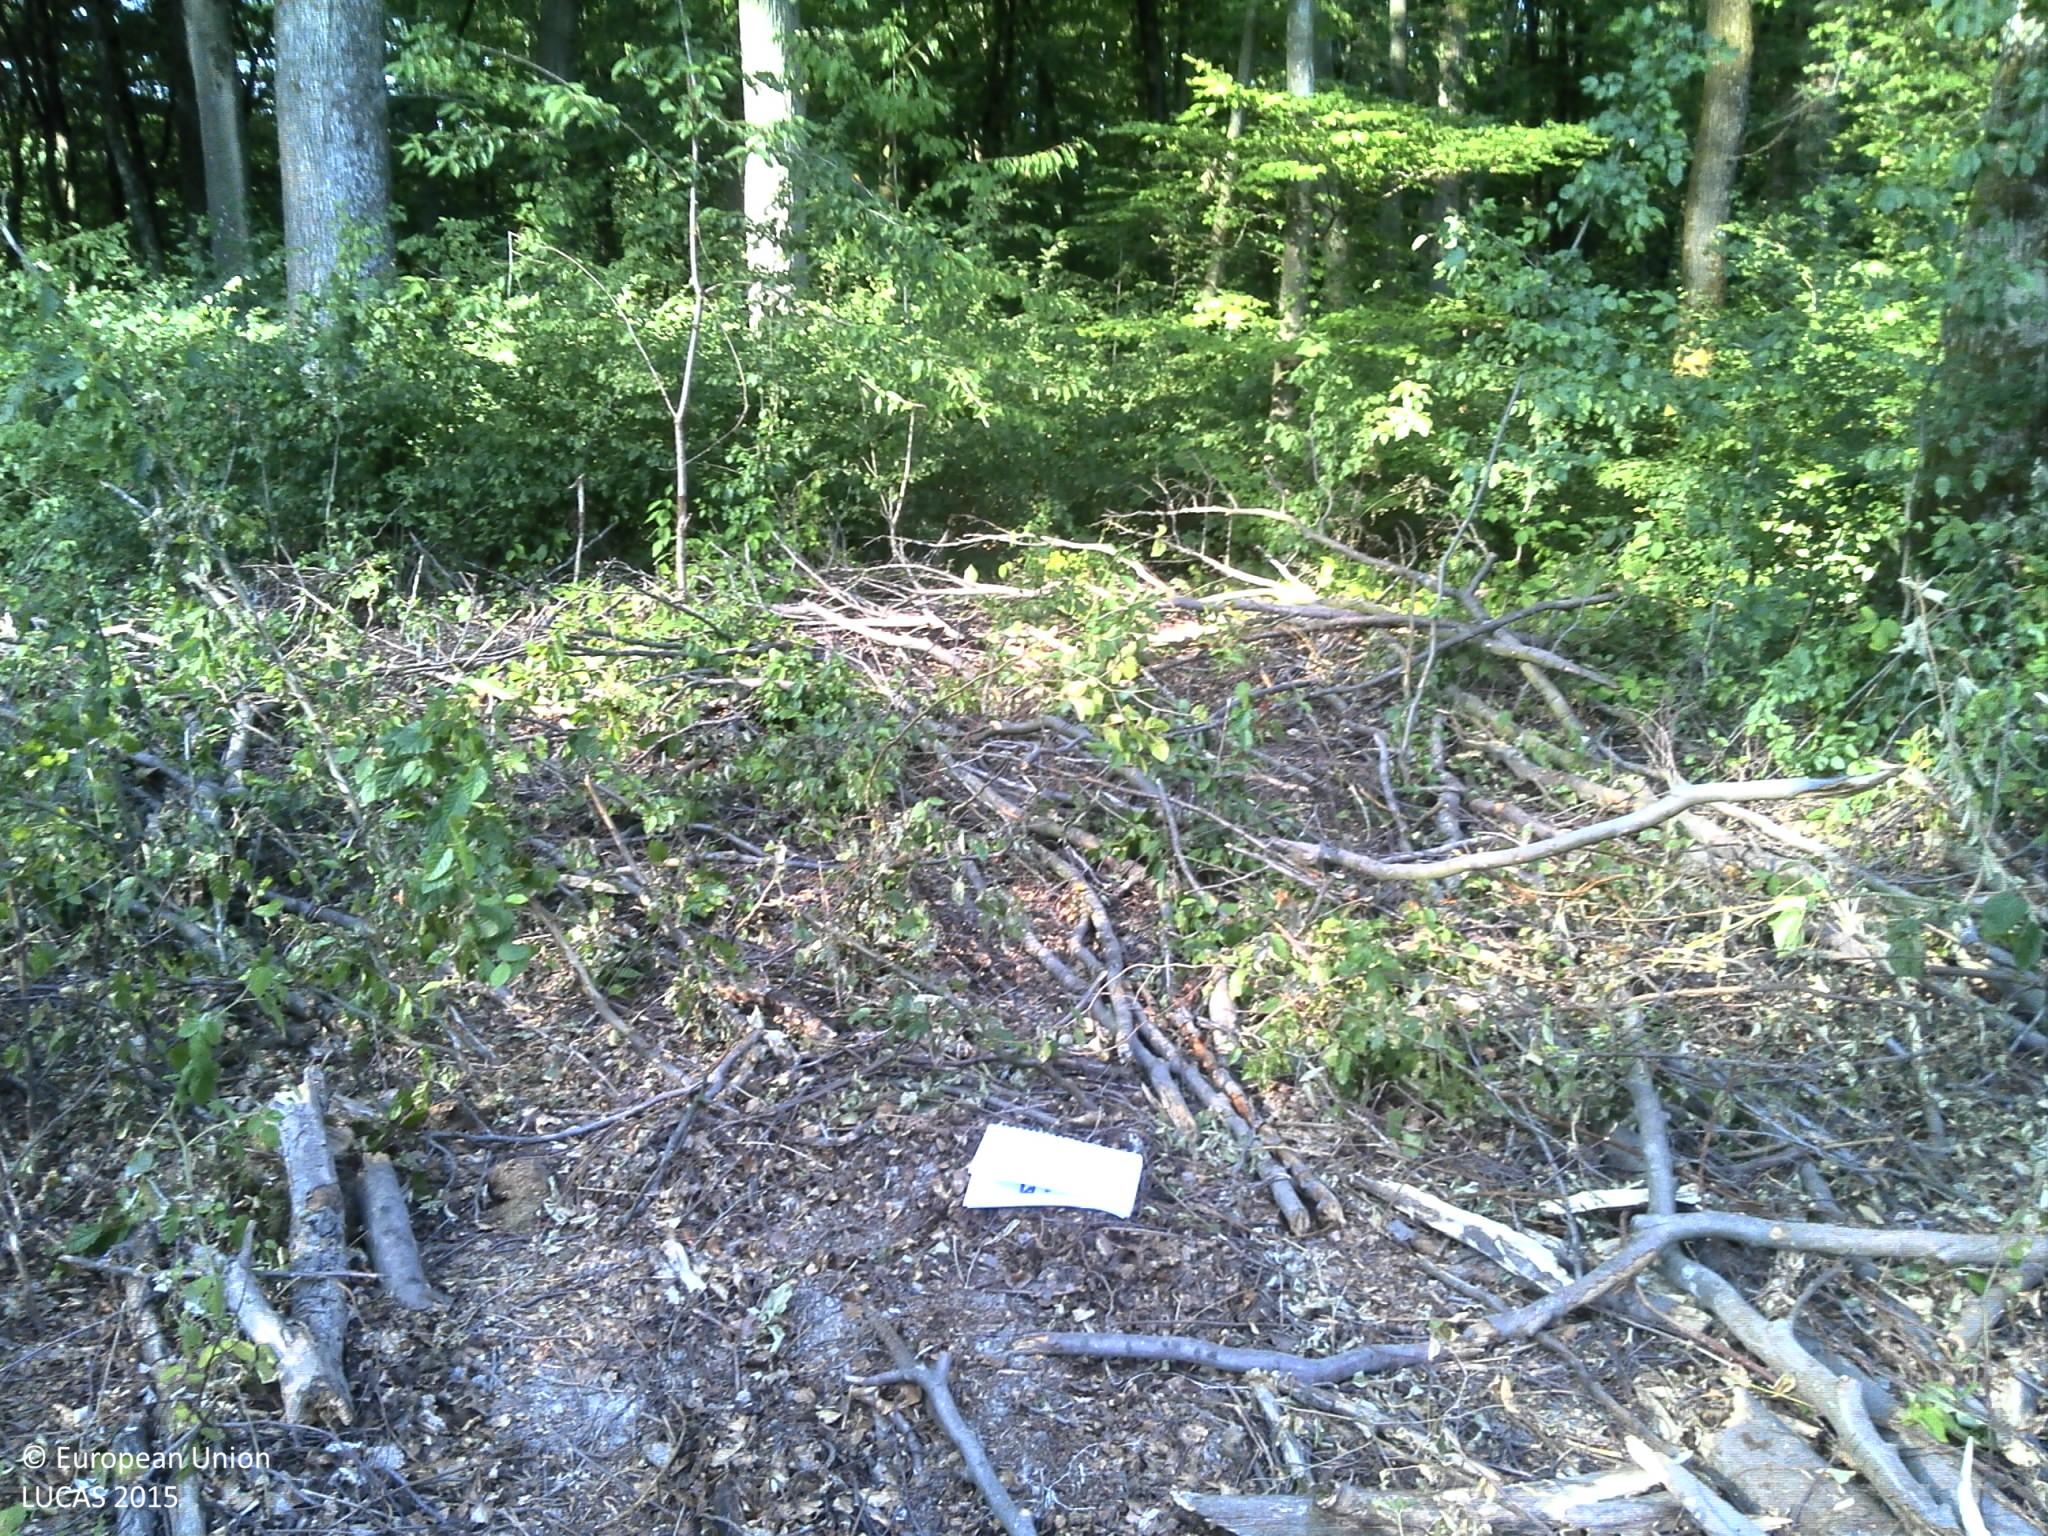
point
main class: Woodland
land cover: Broadleaved woodland
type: mesophytic deciduous forest
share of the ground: > 75 %
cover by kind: broadleaved forest trees 95 %, herbaceous plants 5 %
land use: Forestry
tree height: > 5 m
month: July
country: FR
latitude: 49.0957
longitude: 6.8093
